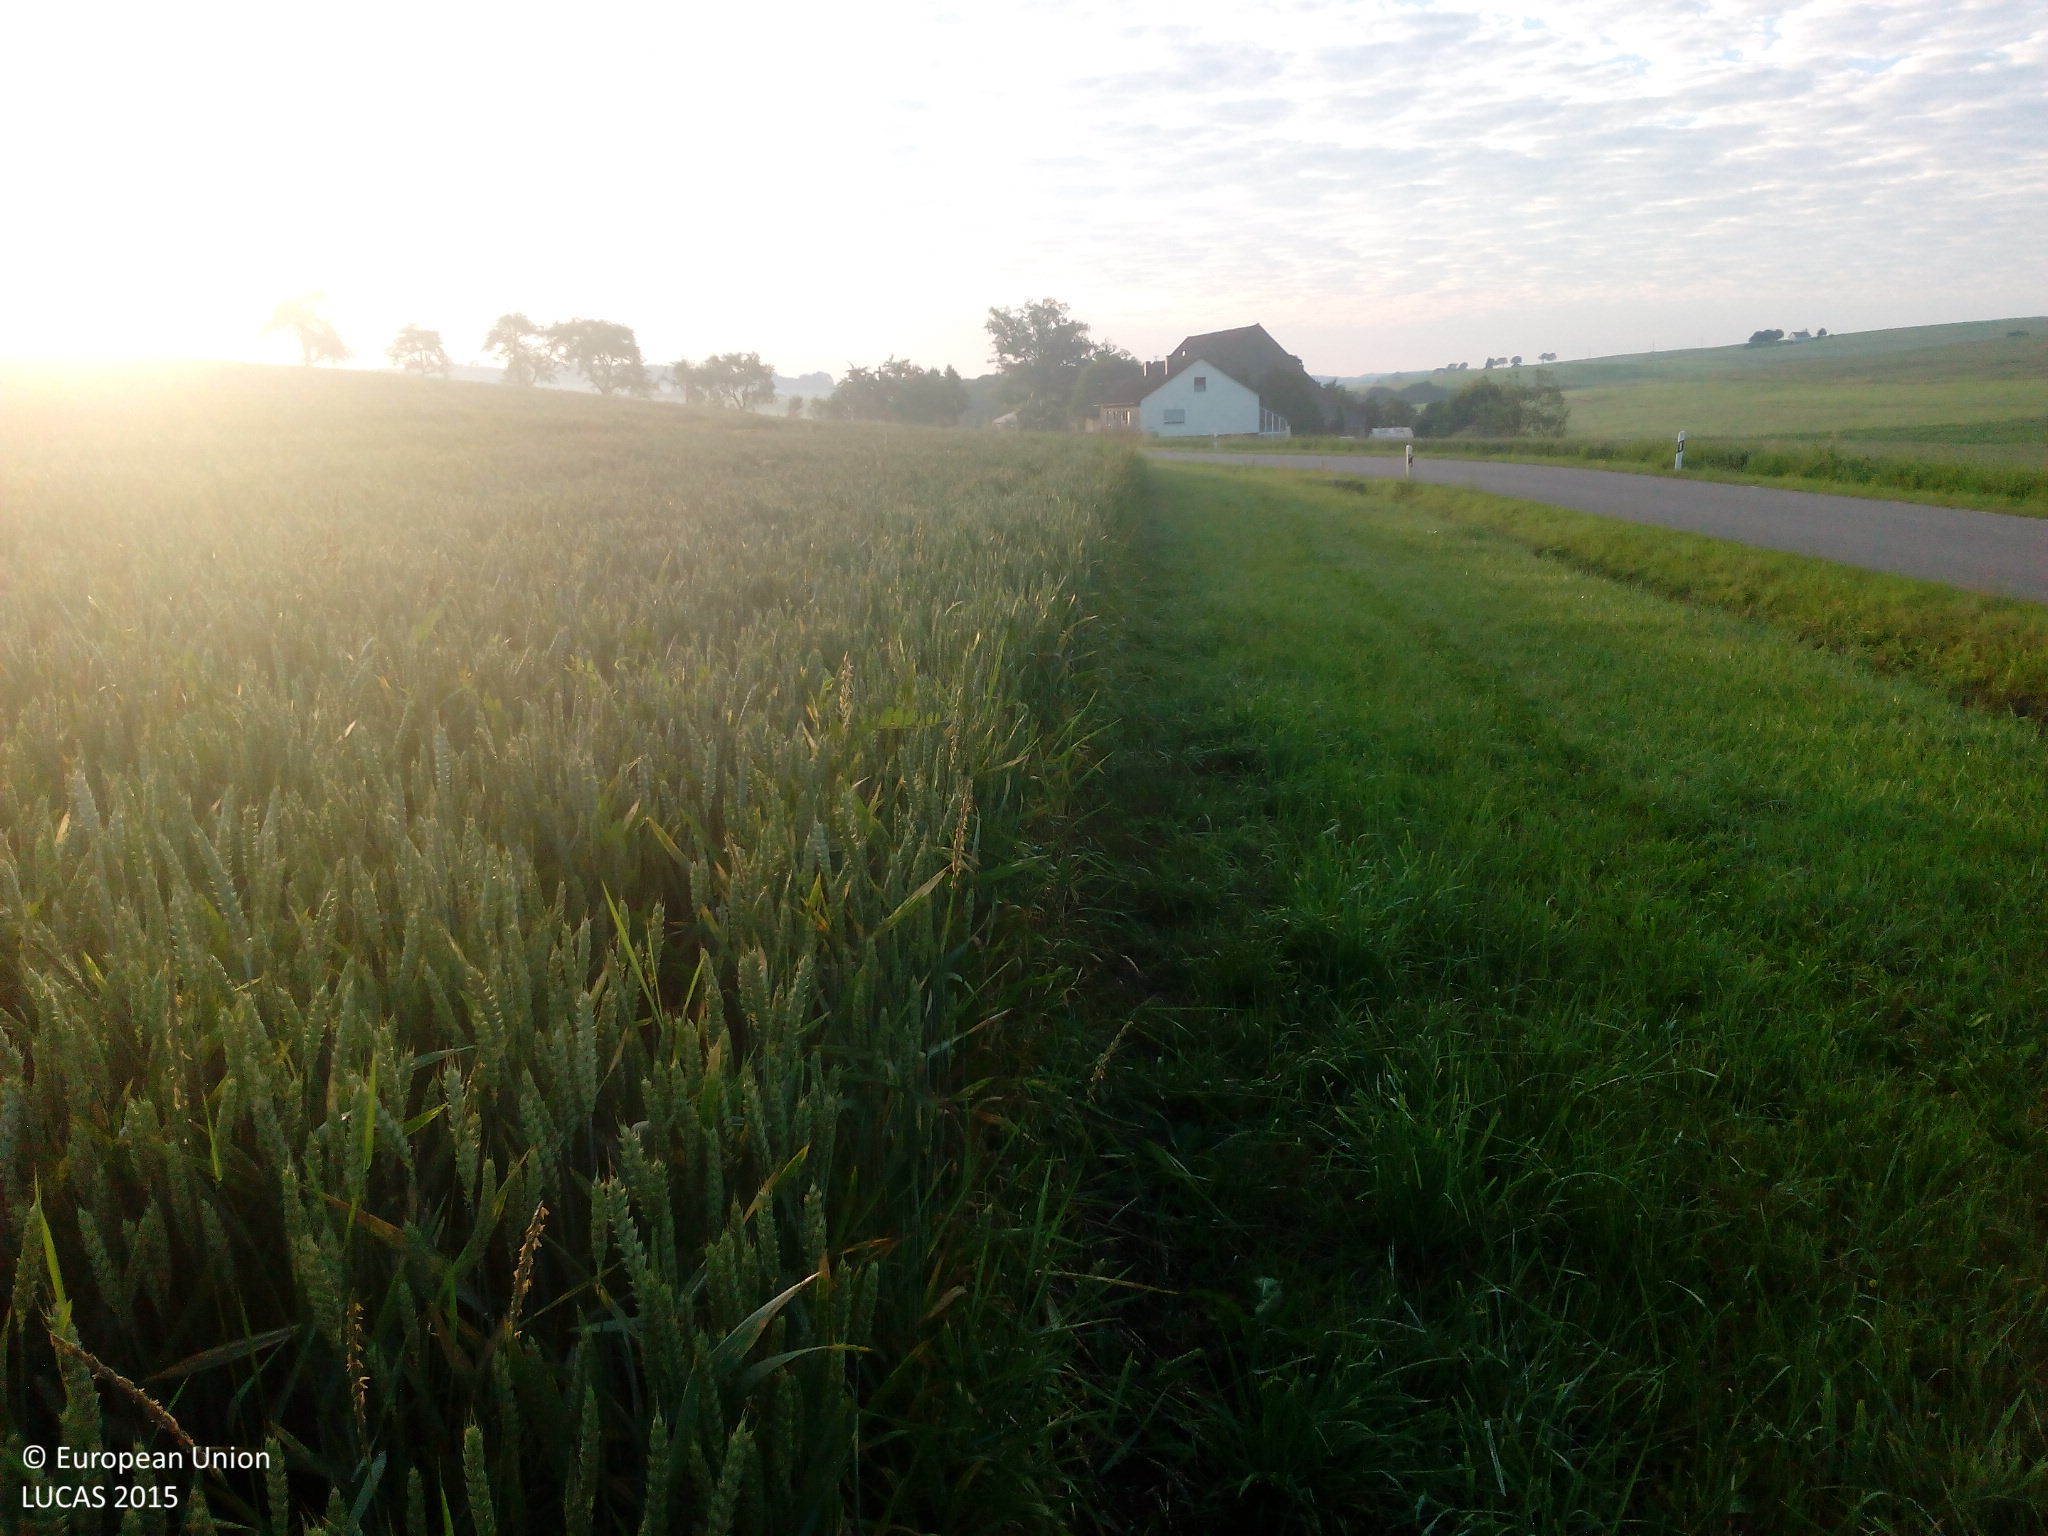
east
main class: Cropland
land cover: Common wheat
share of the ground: > 75 %
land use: Agriculture (excluding fallow land and kitchen gardens)
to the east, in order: Common wheat; Grassland without tree/shrub cover; Ditches and canals; Grass margins; Tracks; Lines of trees; Grassland without tree/shrub cover
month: July
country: DE
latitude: 48.8678
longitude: 10.8857
